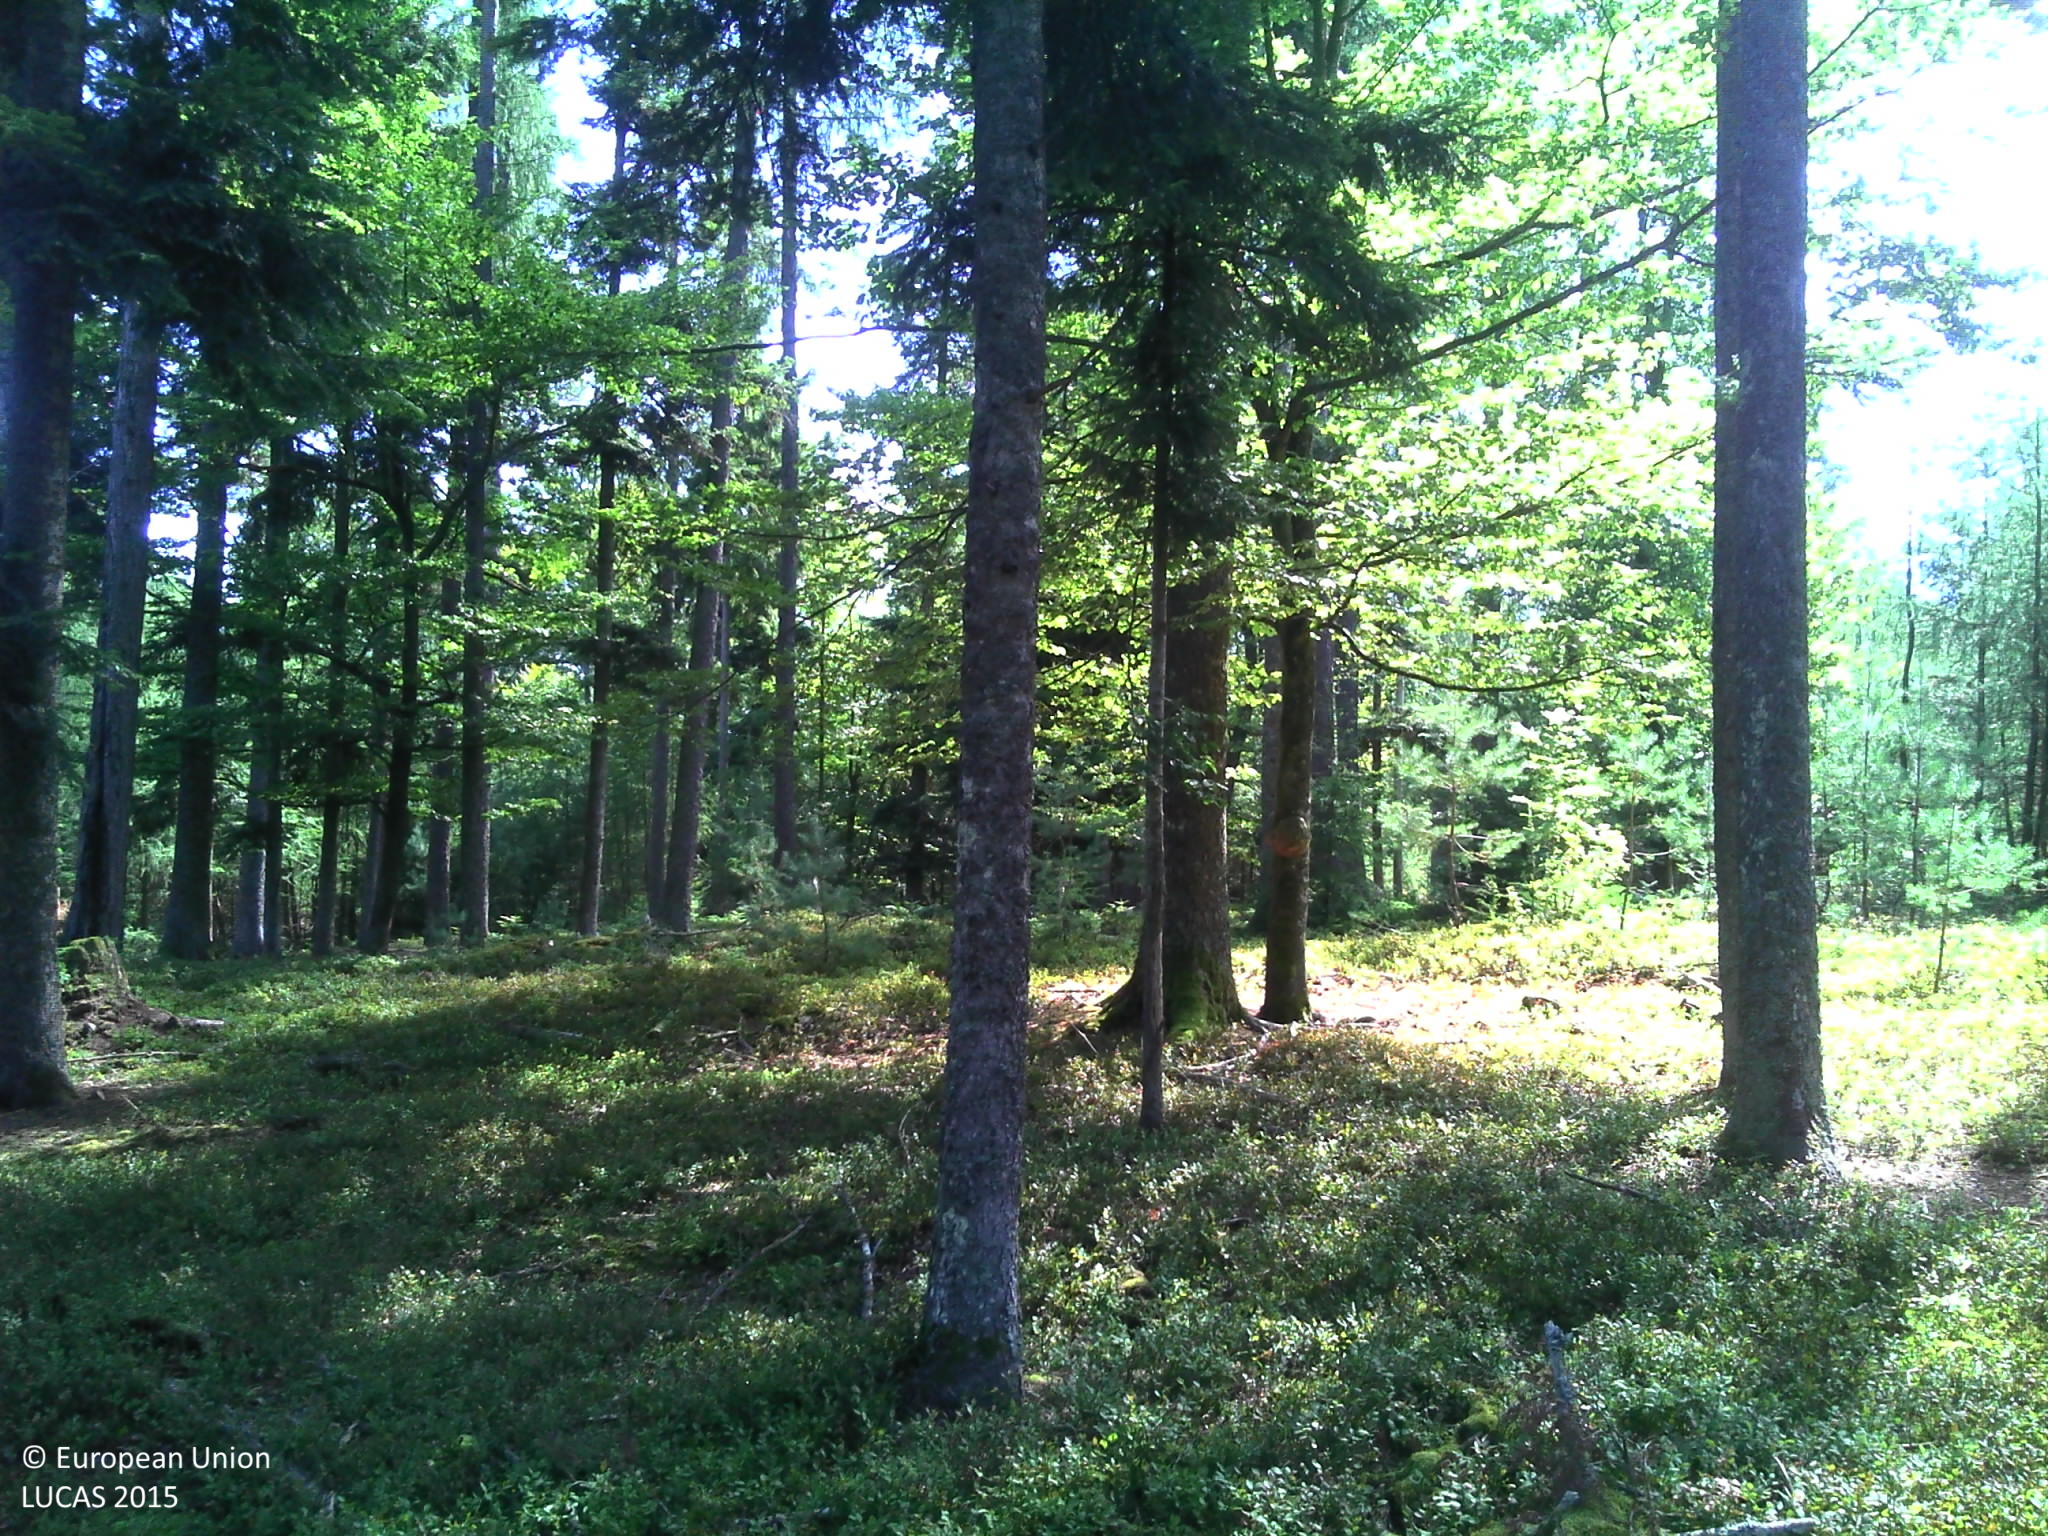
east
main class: Woodland
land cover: Spruce dominated mixed woodland
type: hemiboreal forest and nemoral coniferous forest and mixed broadleaved-coniferous forest
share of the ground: > 75 %
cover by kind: coniferous forest trees 60 %, broadleaved forest trees 30 %, herbaceous plants 10 %
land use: Forestry
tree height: > 5 m
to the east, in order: Spruce dominated mixed woodland; Tracks; Spruce dominated mixed woodland; Fences; Spruce dominated mixed woodland; Fences; Spruce dominated mixed woodland
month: August
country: FR
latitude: 48.2637
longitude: 7.3472
